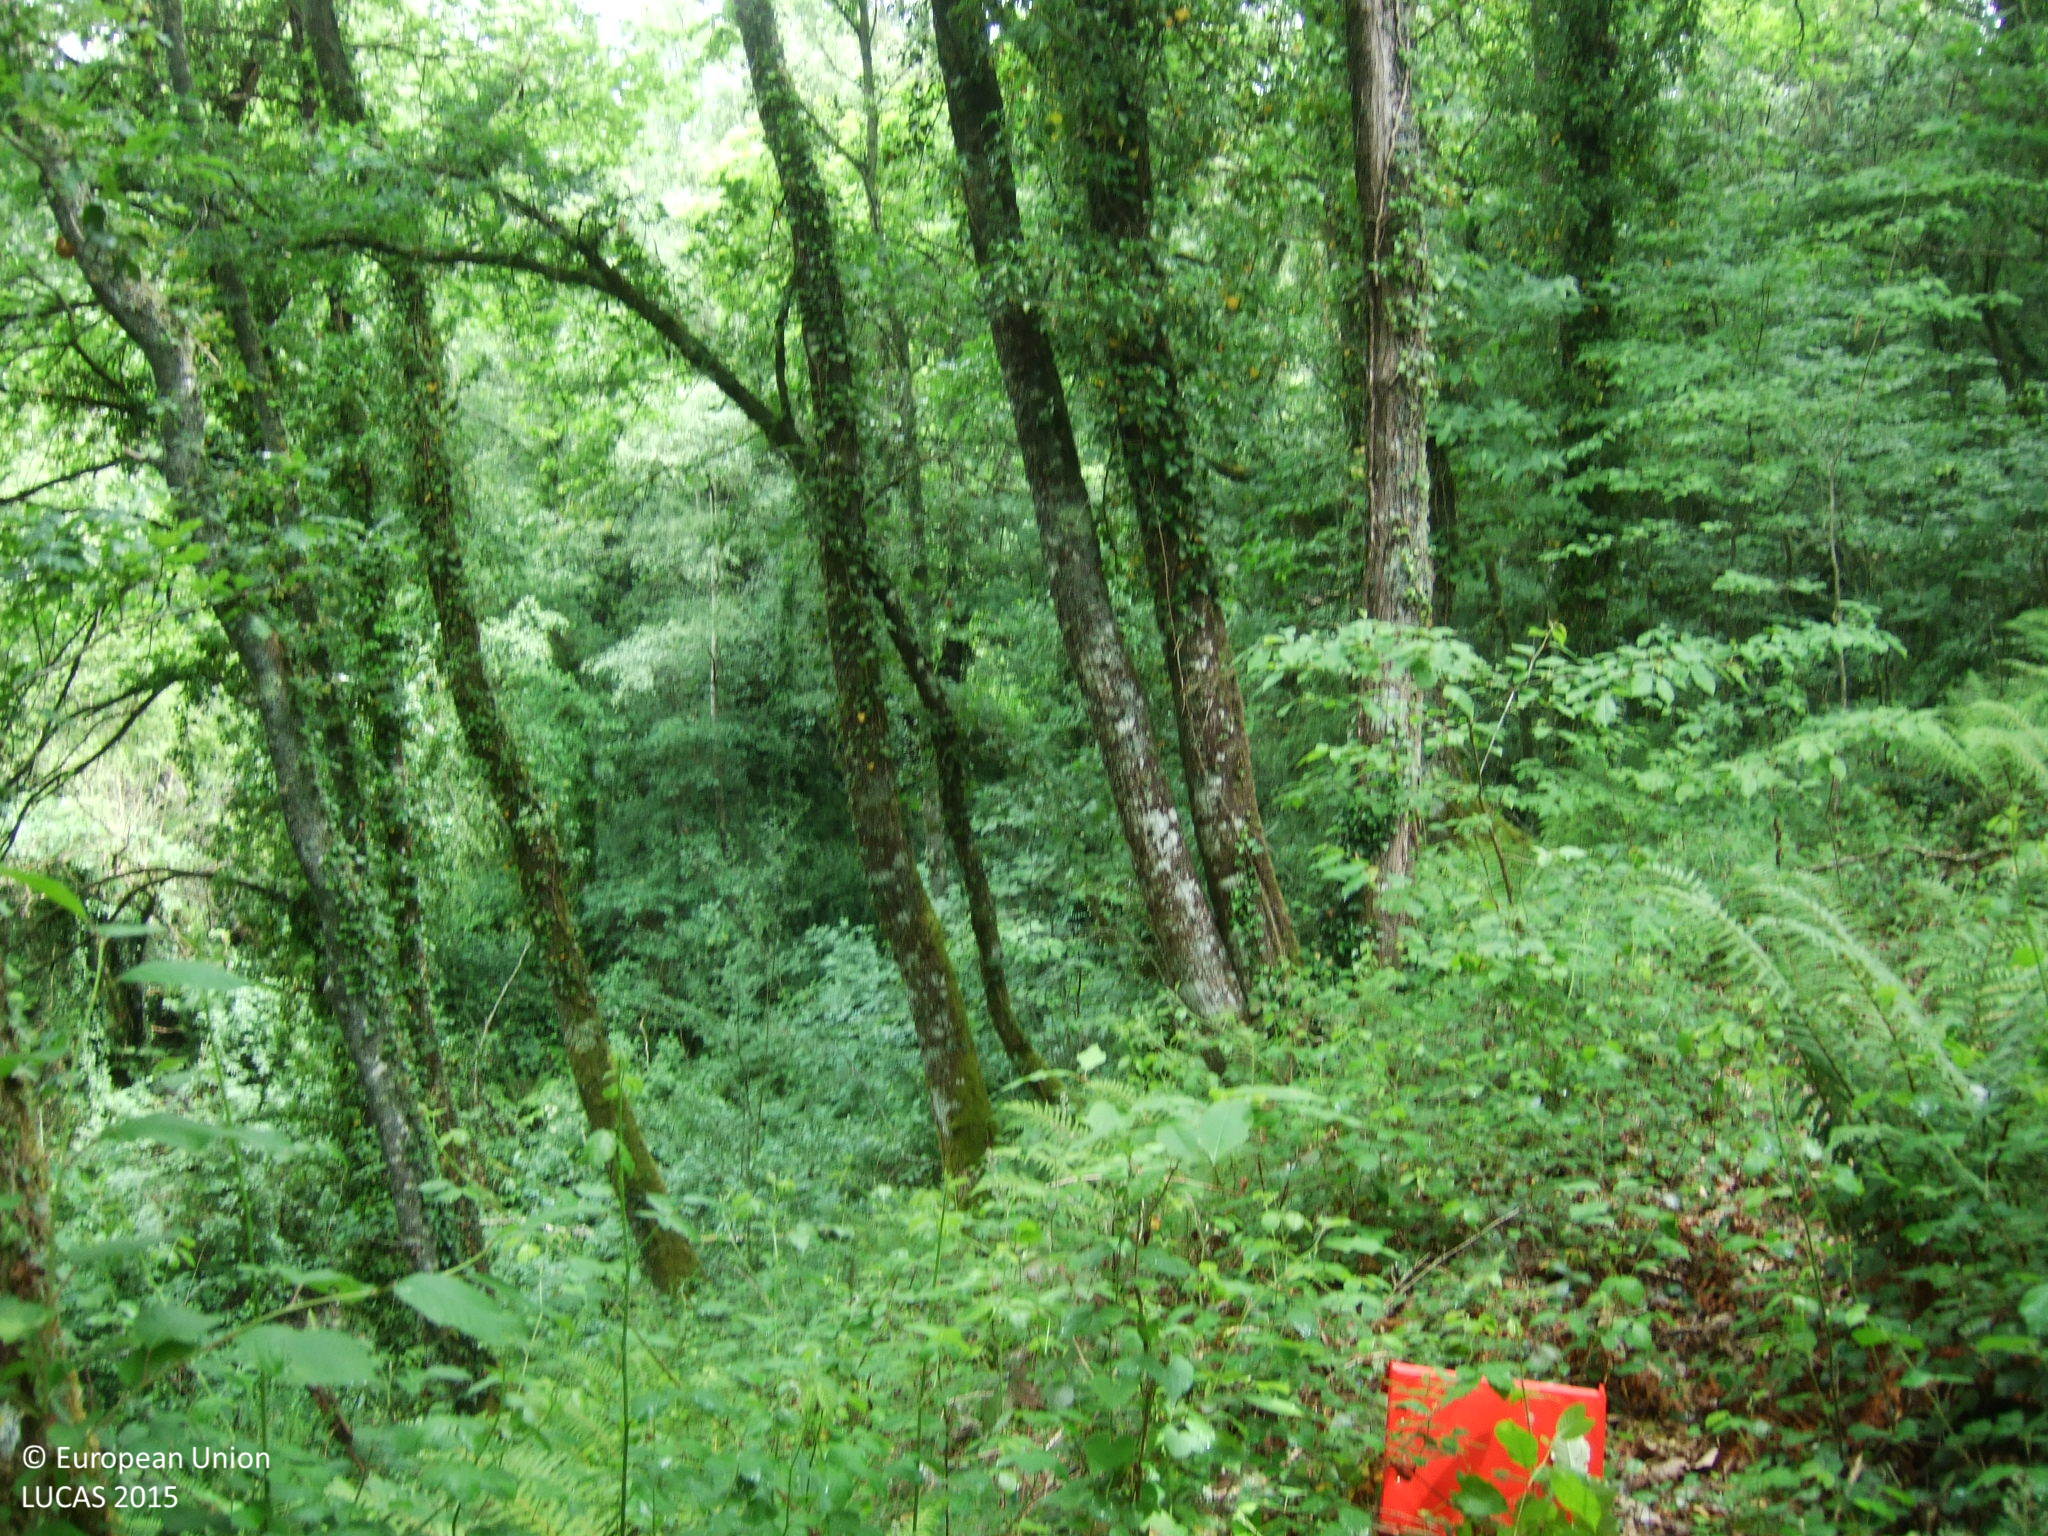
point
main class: Woodland
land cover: Broadleaved woodland
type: acidophilous oak and oak-birch forest
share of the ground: > 75 %
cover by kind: broadleaved forest trees 80 %, shrubs 20 %
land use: Forestry
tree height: > 5 m
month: June
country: ES
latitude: 42.7497
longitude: -7.3307
